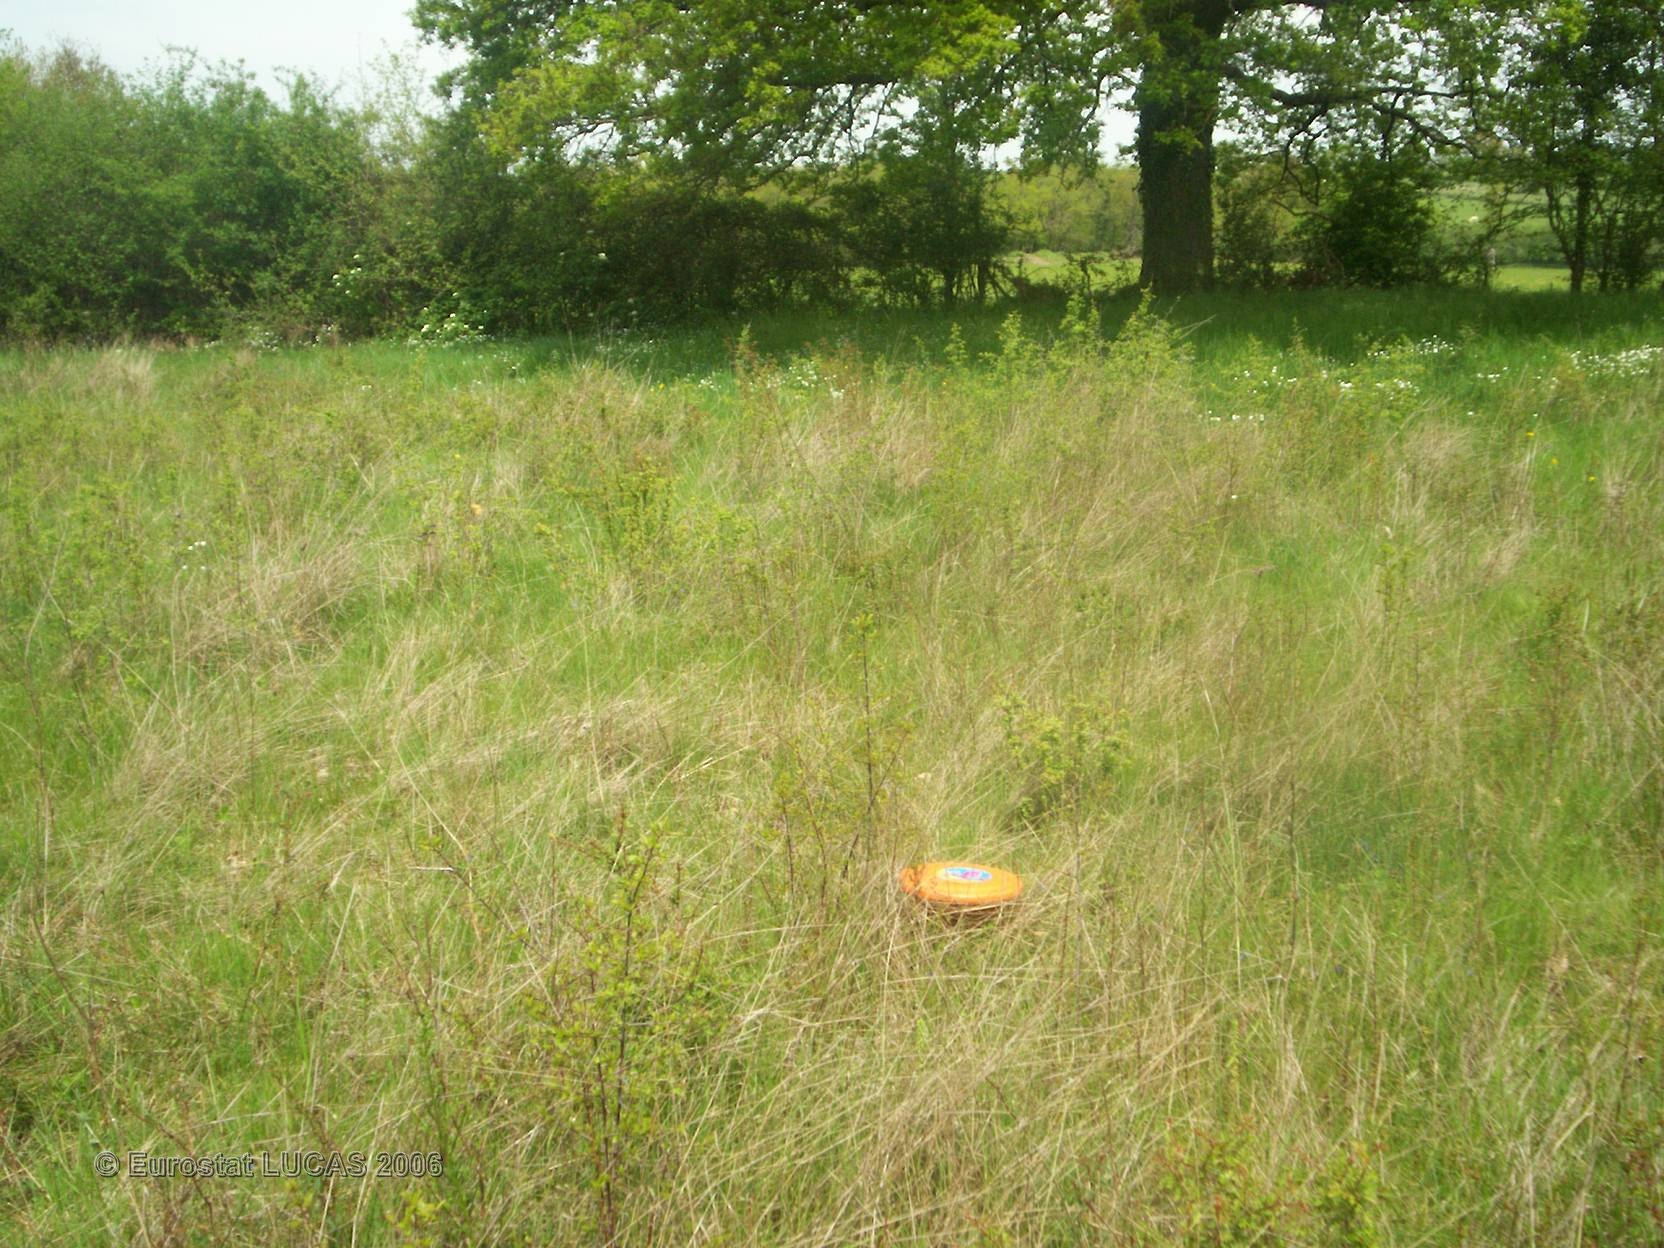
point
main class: Grassland
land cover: Grassland with sparse tree/shrub cover
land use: Unused
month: May
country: FR
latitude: 46.2734
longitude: 3.1077
